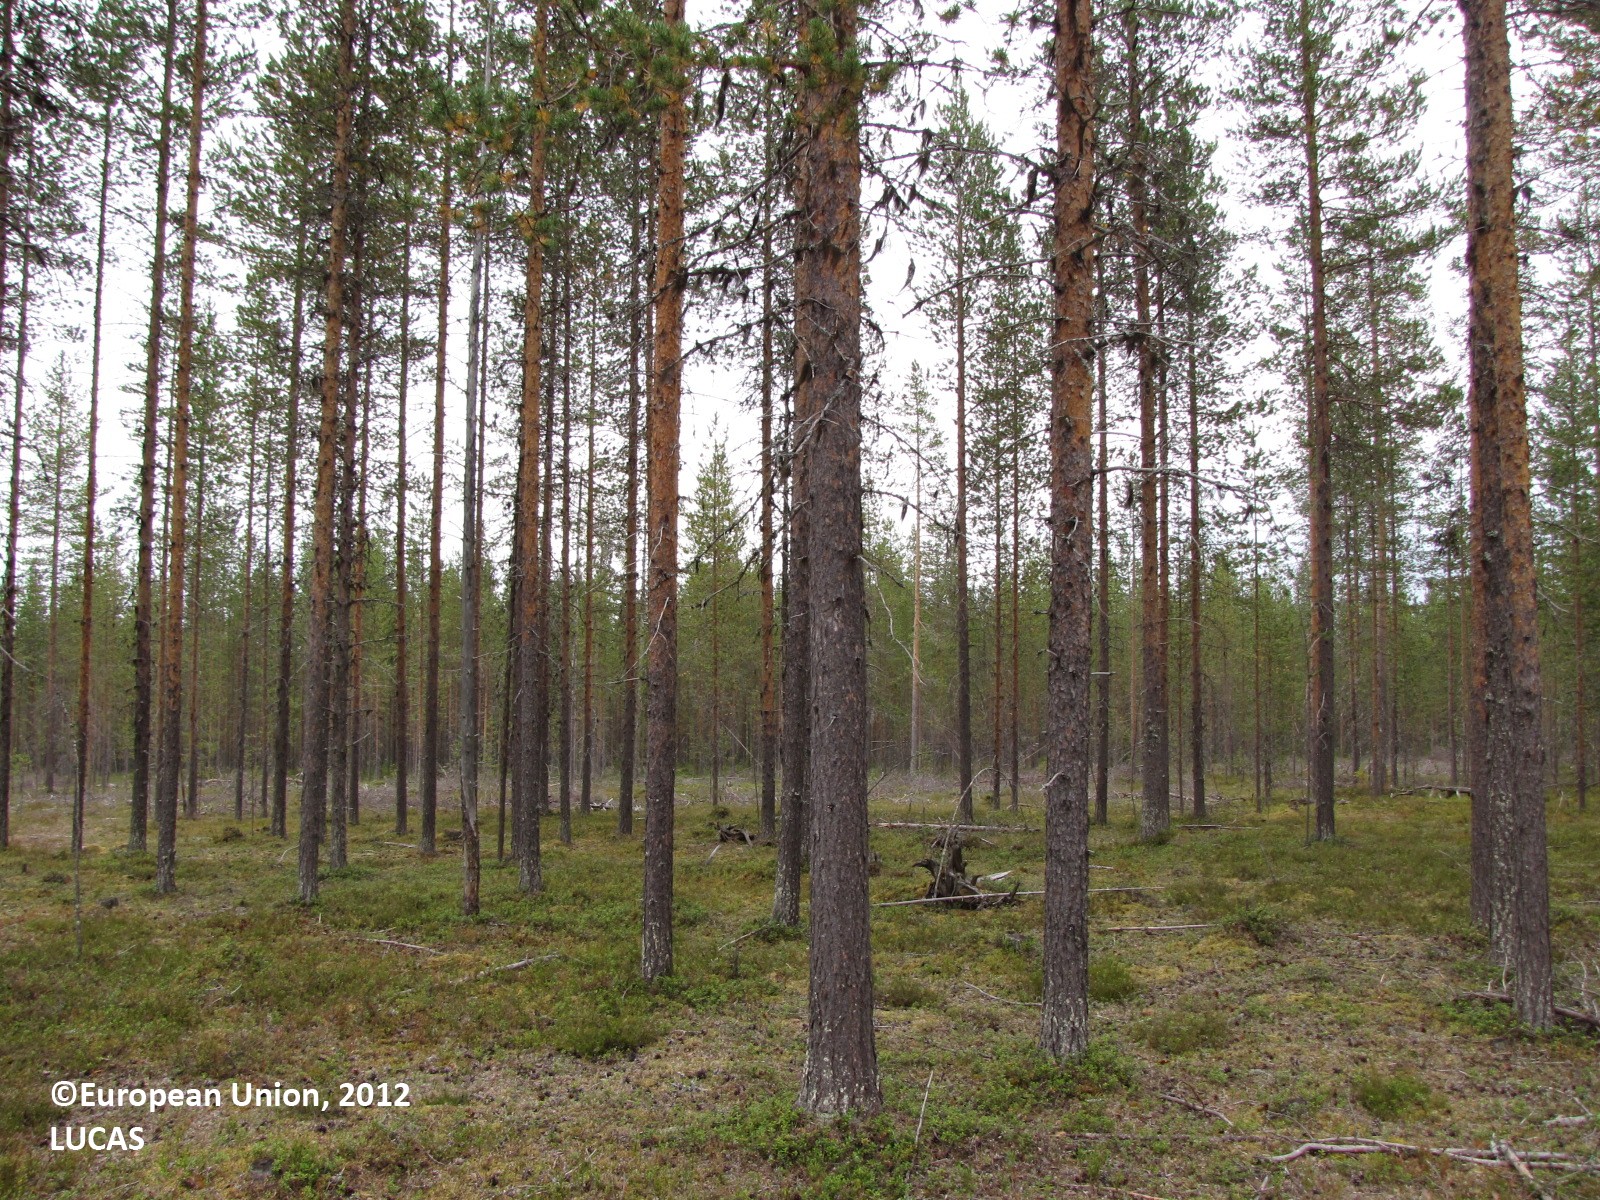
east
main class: Woodland
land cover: Pine dominated coniferous woodland
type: boreal forest
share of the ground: 25 - 50 %
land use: Forestry
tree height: > 5 m
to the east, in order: Pine dominated coniferous woodland; Ditches and canals; Pine dominated coniferous woodland; Peatbogs
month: August
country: FI
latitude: 67.0502
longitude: 25.1480
